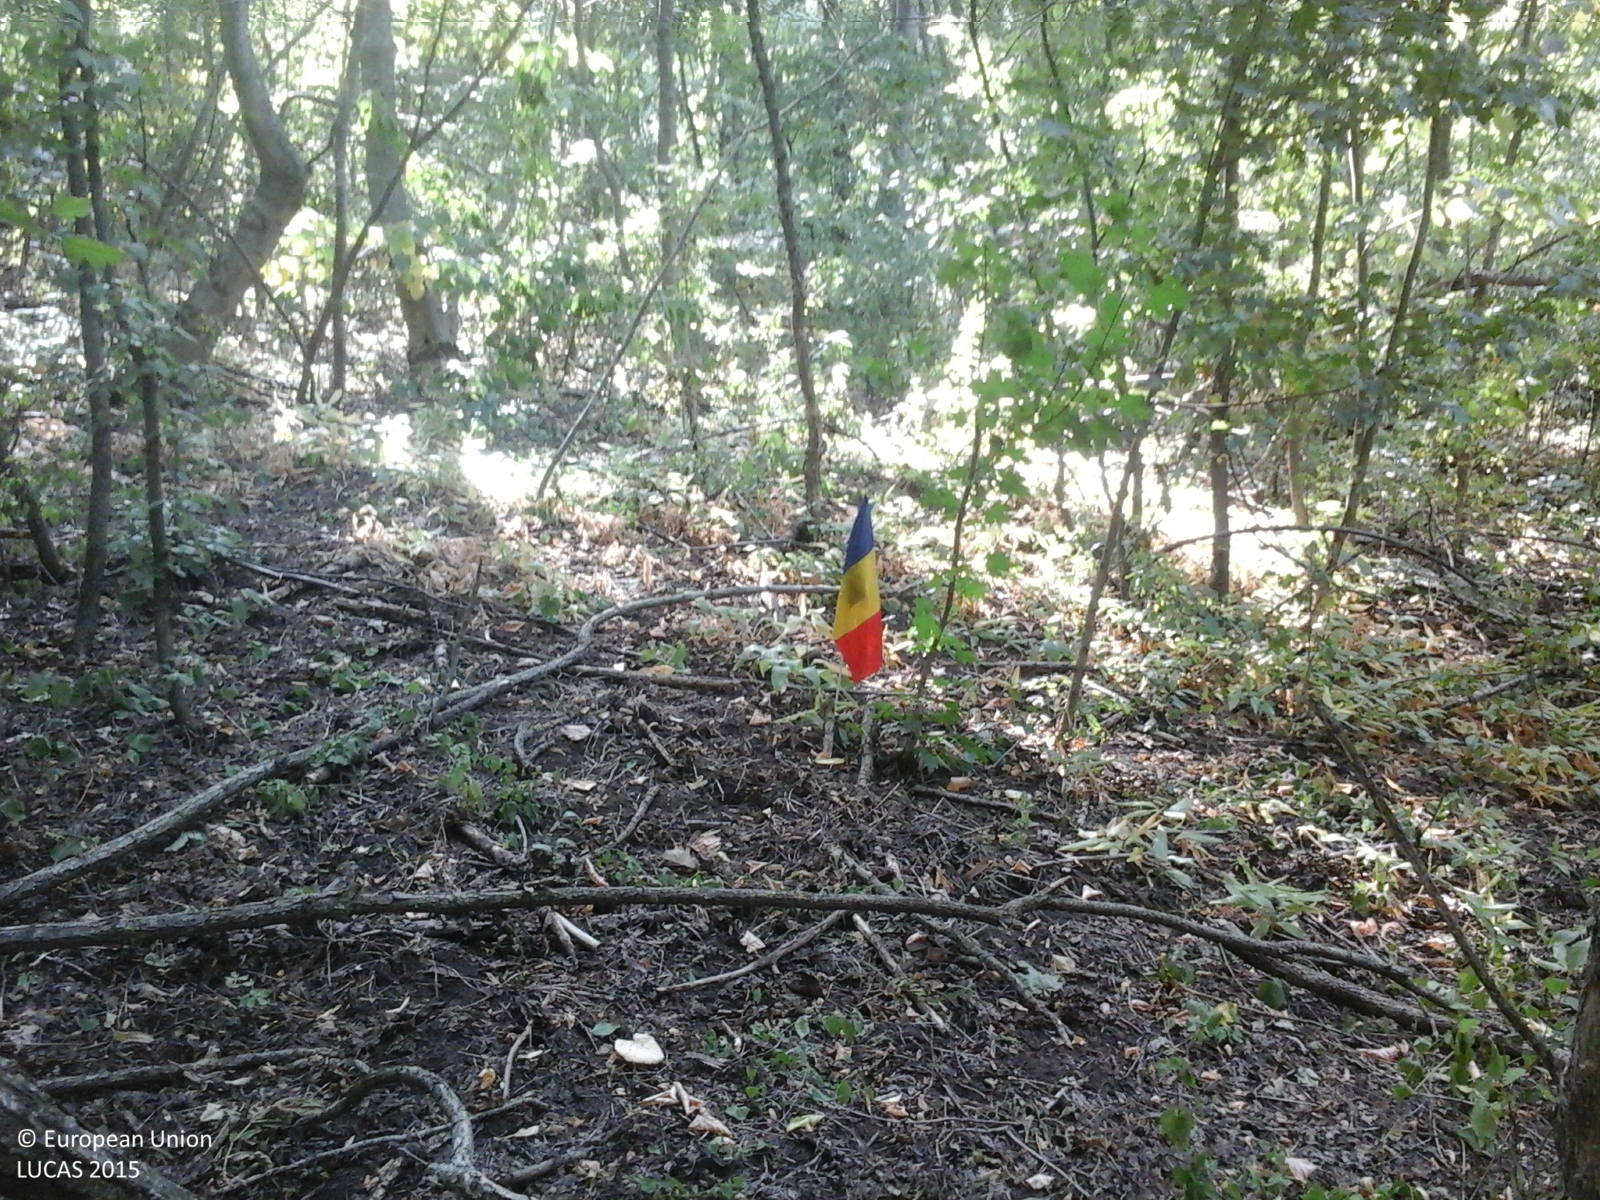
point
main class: Woodland
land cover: Broadleaved woodland
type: acidophilous oak and oak-birch forest
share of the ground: > 75 %
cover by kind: broadleaved forest trees 100 %
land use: Forestry
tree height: > 5 m
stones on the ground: < 10 %
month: July
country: RO
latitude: 46.2484
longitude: 27.8771
